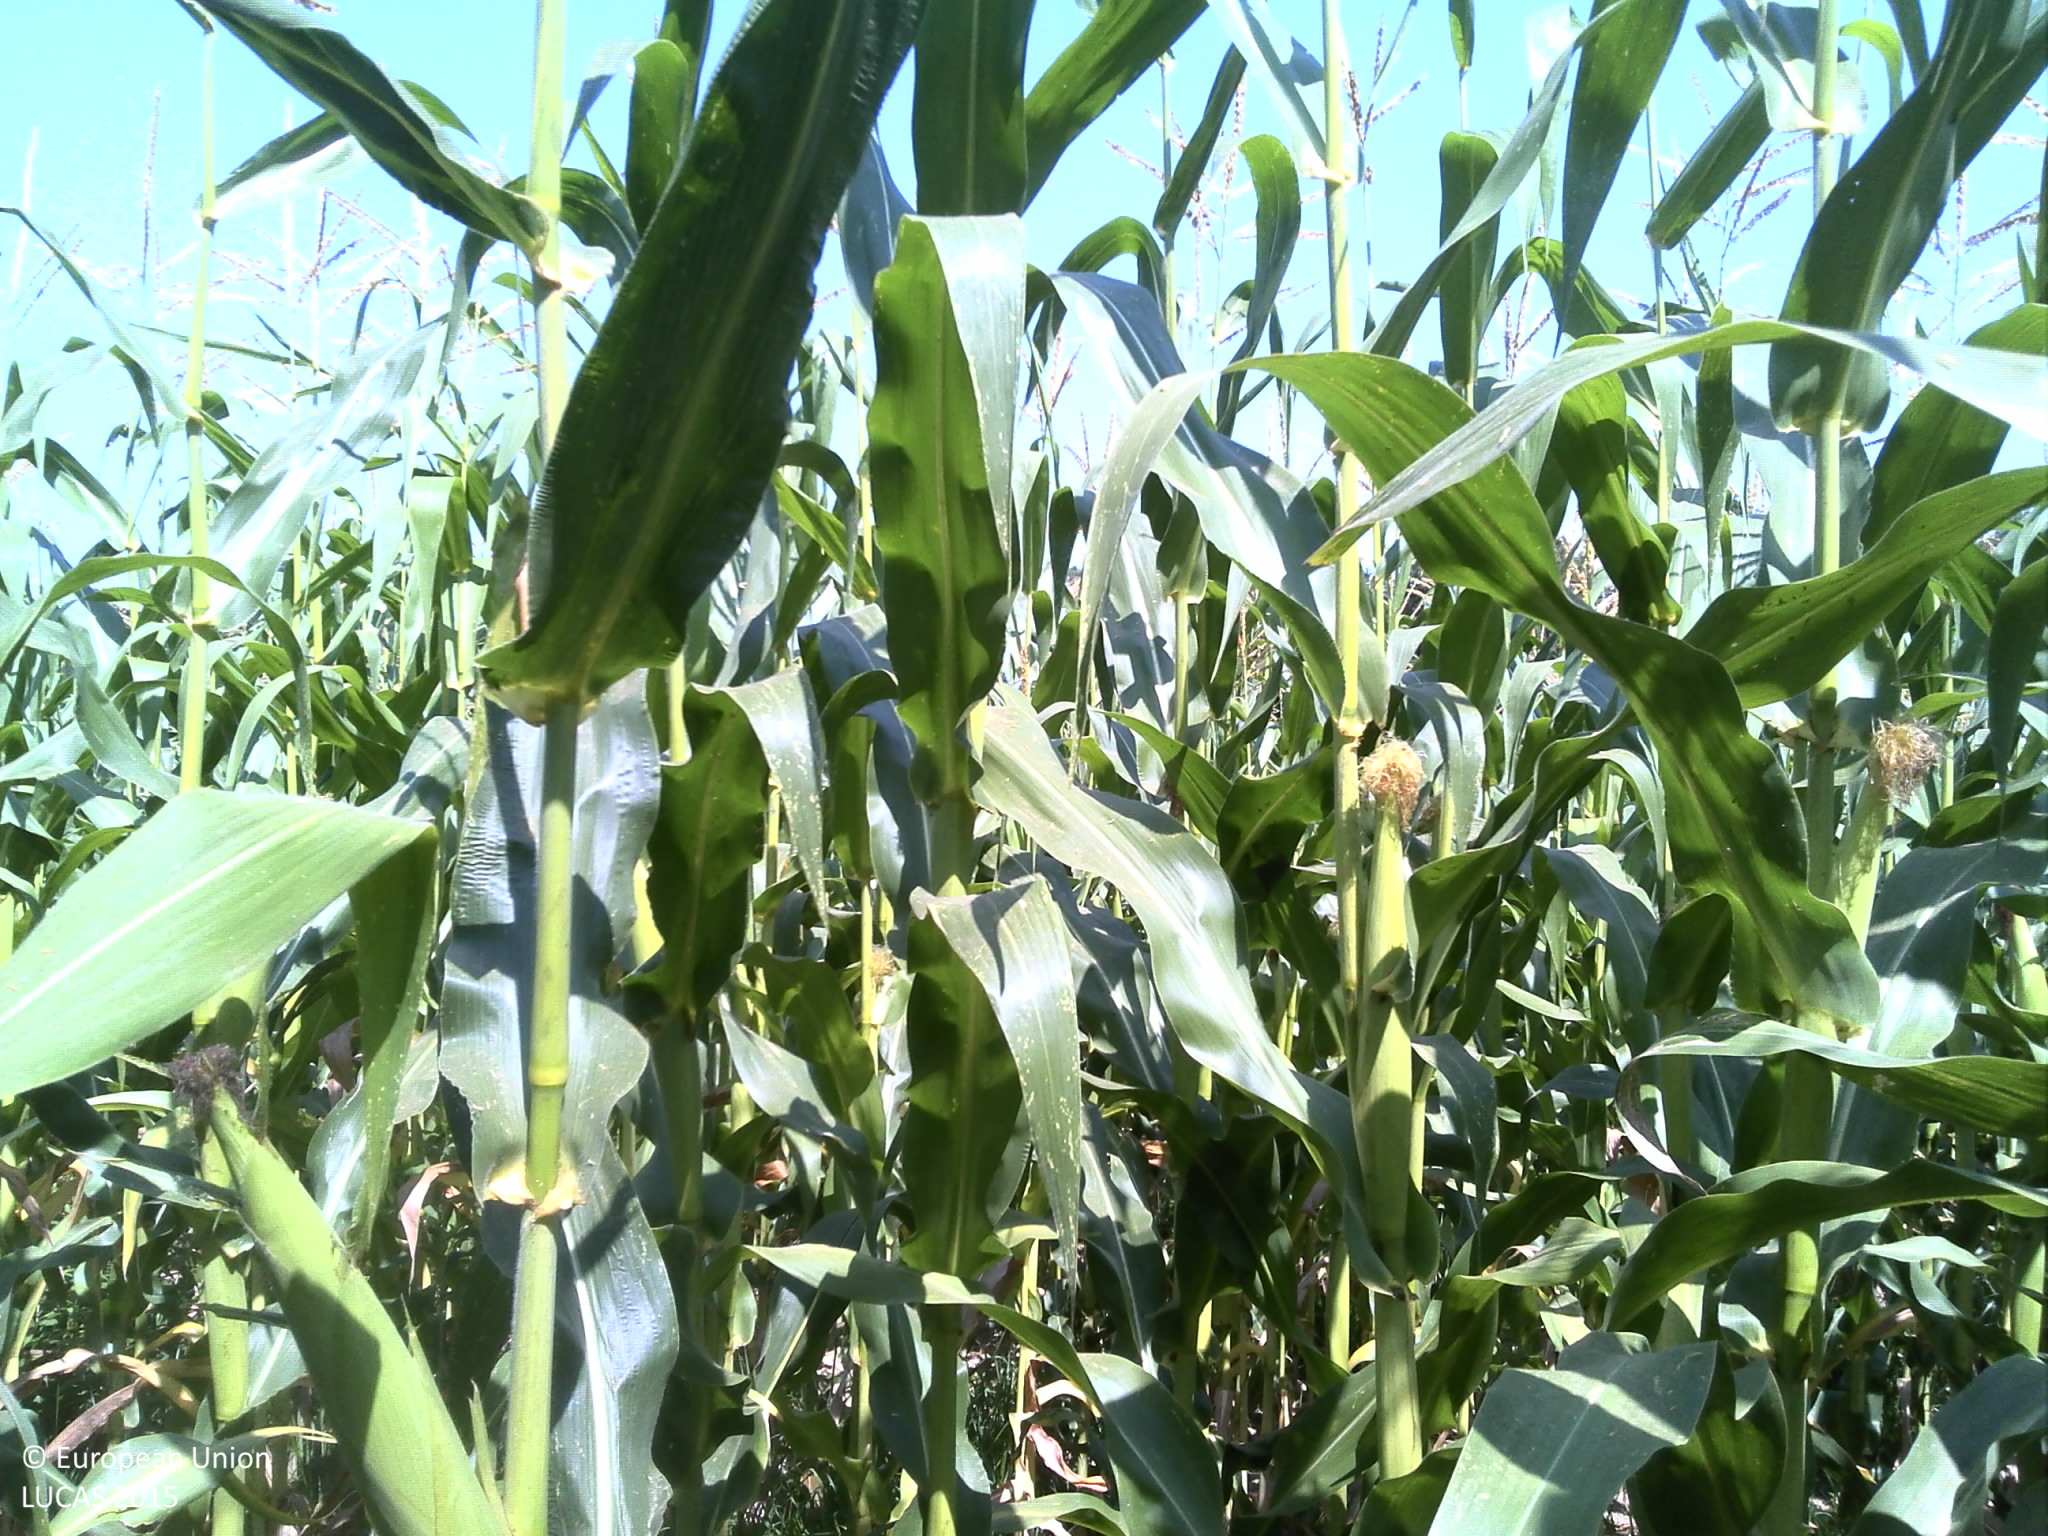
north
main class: Cropland
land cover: Maize
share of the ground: > 75 %
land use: Agriculture (excluding fallow land and kitchen gardens)
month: July
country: HR
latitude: 45.7143
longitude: 16.8728
